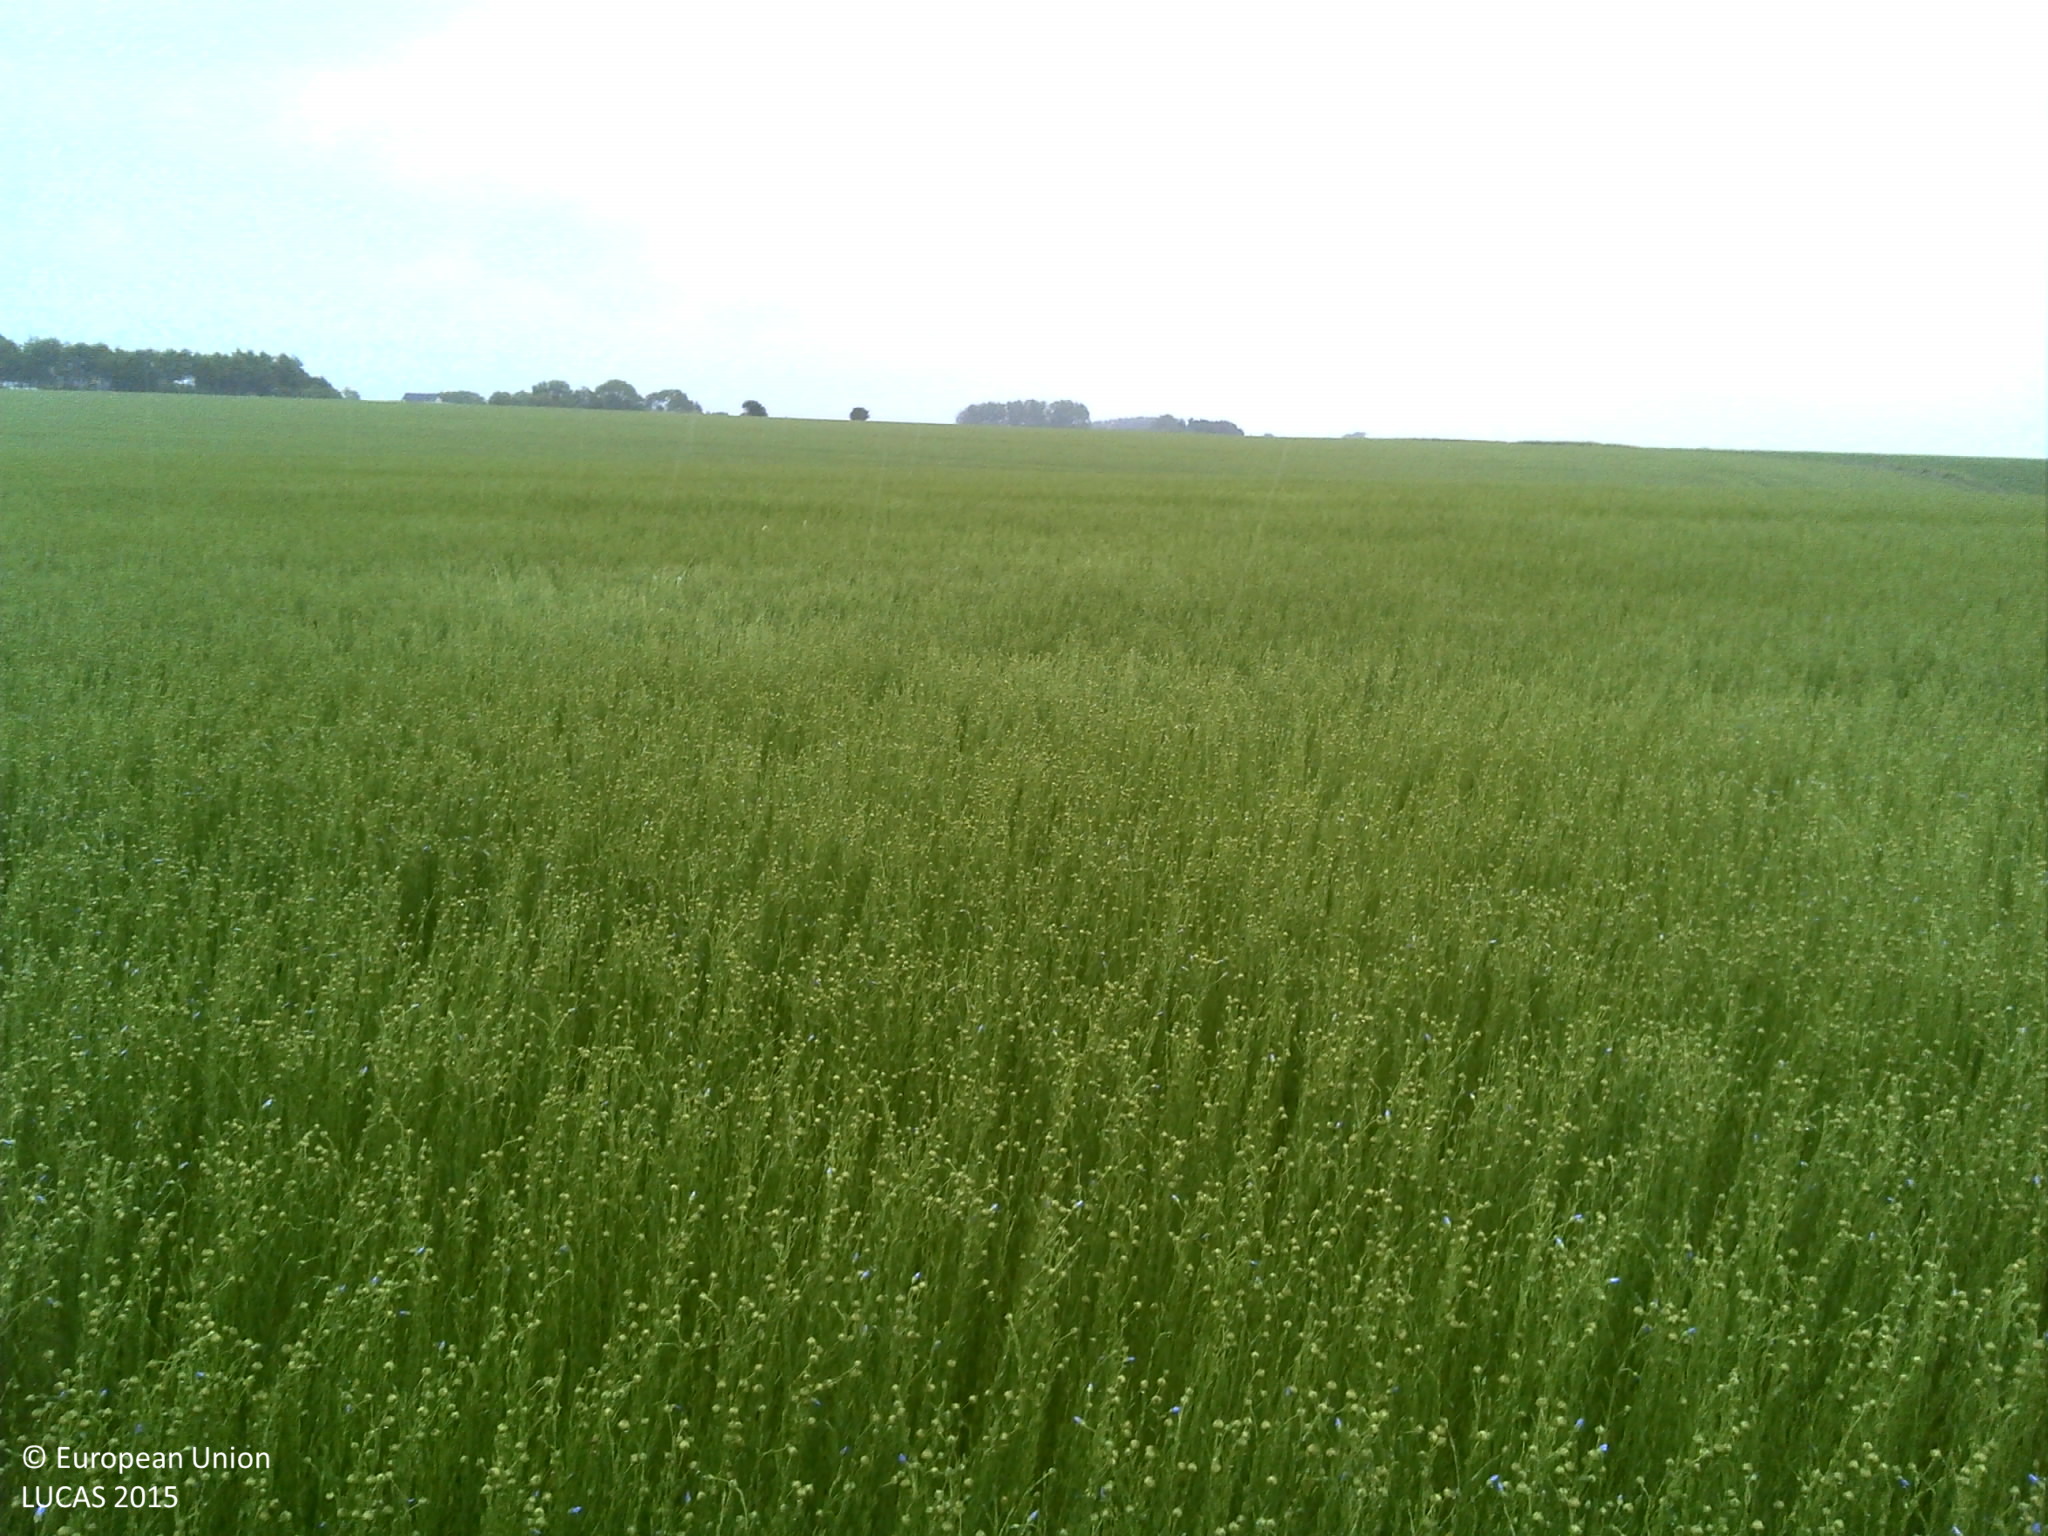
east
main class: Cropland
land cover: Other fibre and oleaginous crops
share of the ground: > 75 %
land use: Agriculture (excluding fallow land and kitchen gardens)
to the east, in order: Other fibre and oleaginous crops
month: June
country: FR
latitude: 49.7134
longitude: 0.2768
